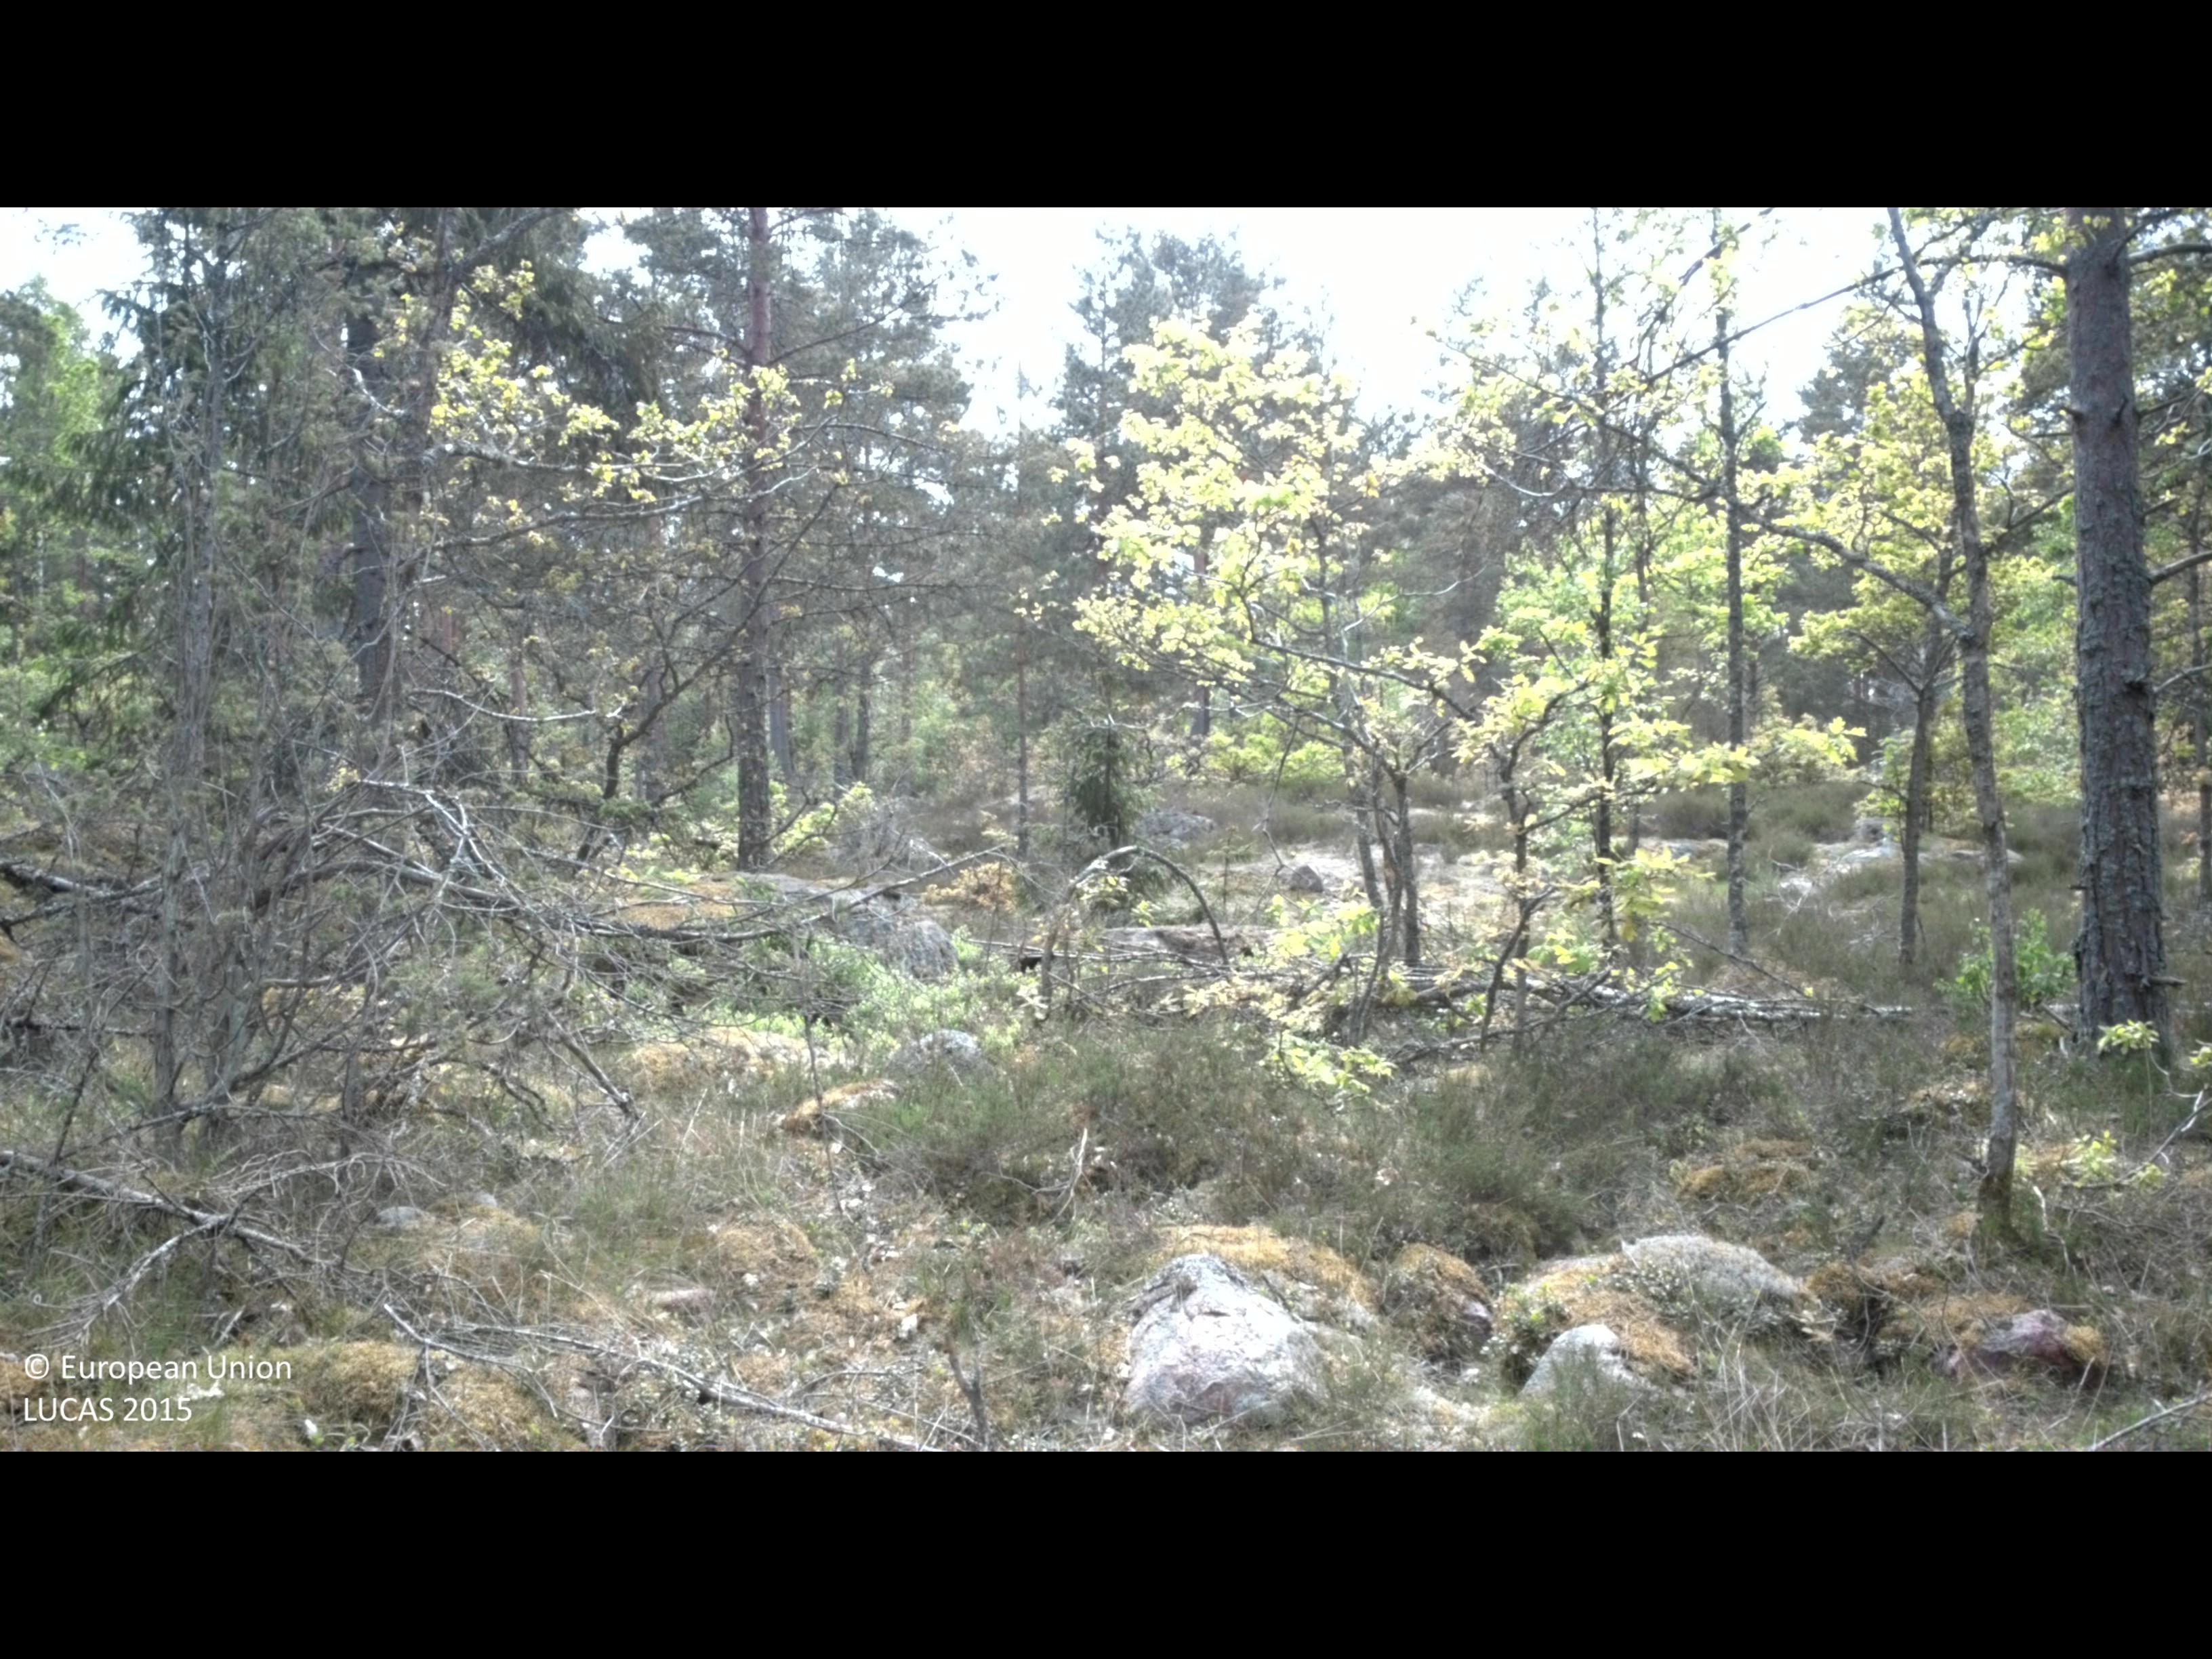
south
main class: Woodland
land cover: Pine dominated coniferous woodland
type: boreal forest
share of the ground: 25 - 50 %
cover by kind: coniferous forest trees 40 %, lichens and mosses 30 %, shrubs 25 %, broadleaved forest trees 5 %
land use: Forestry
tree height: > 5 m
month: May
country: SE
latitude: 57.3567
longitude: 16.5322
